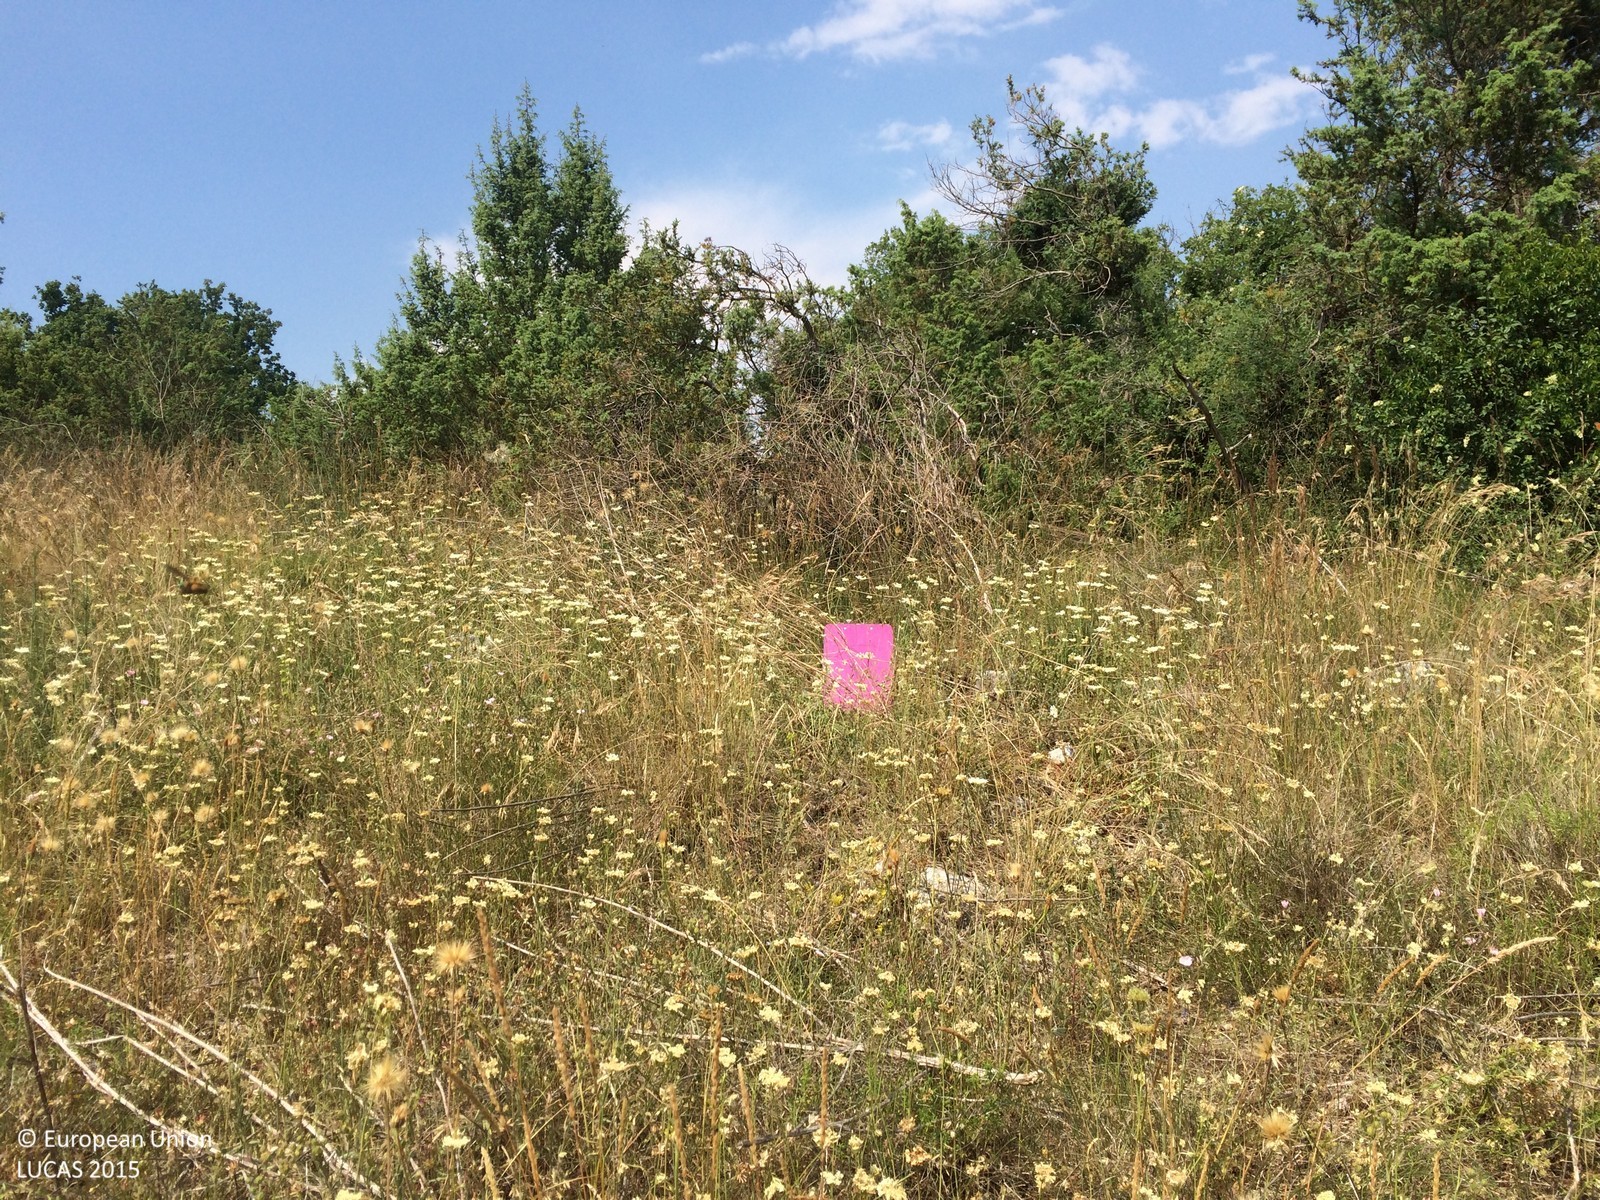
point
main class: Grassland
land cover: Grassland with sparse tree/shrub cover
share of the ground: > 75 %
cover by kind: herbaceous plants 90 %, broadleaved forest trees 5 %, shrubs 5 %
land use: Semi-natural and natural areas not in use
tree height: < 5 m
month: June
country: HR
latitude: 45.0925
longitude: 13.8191
